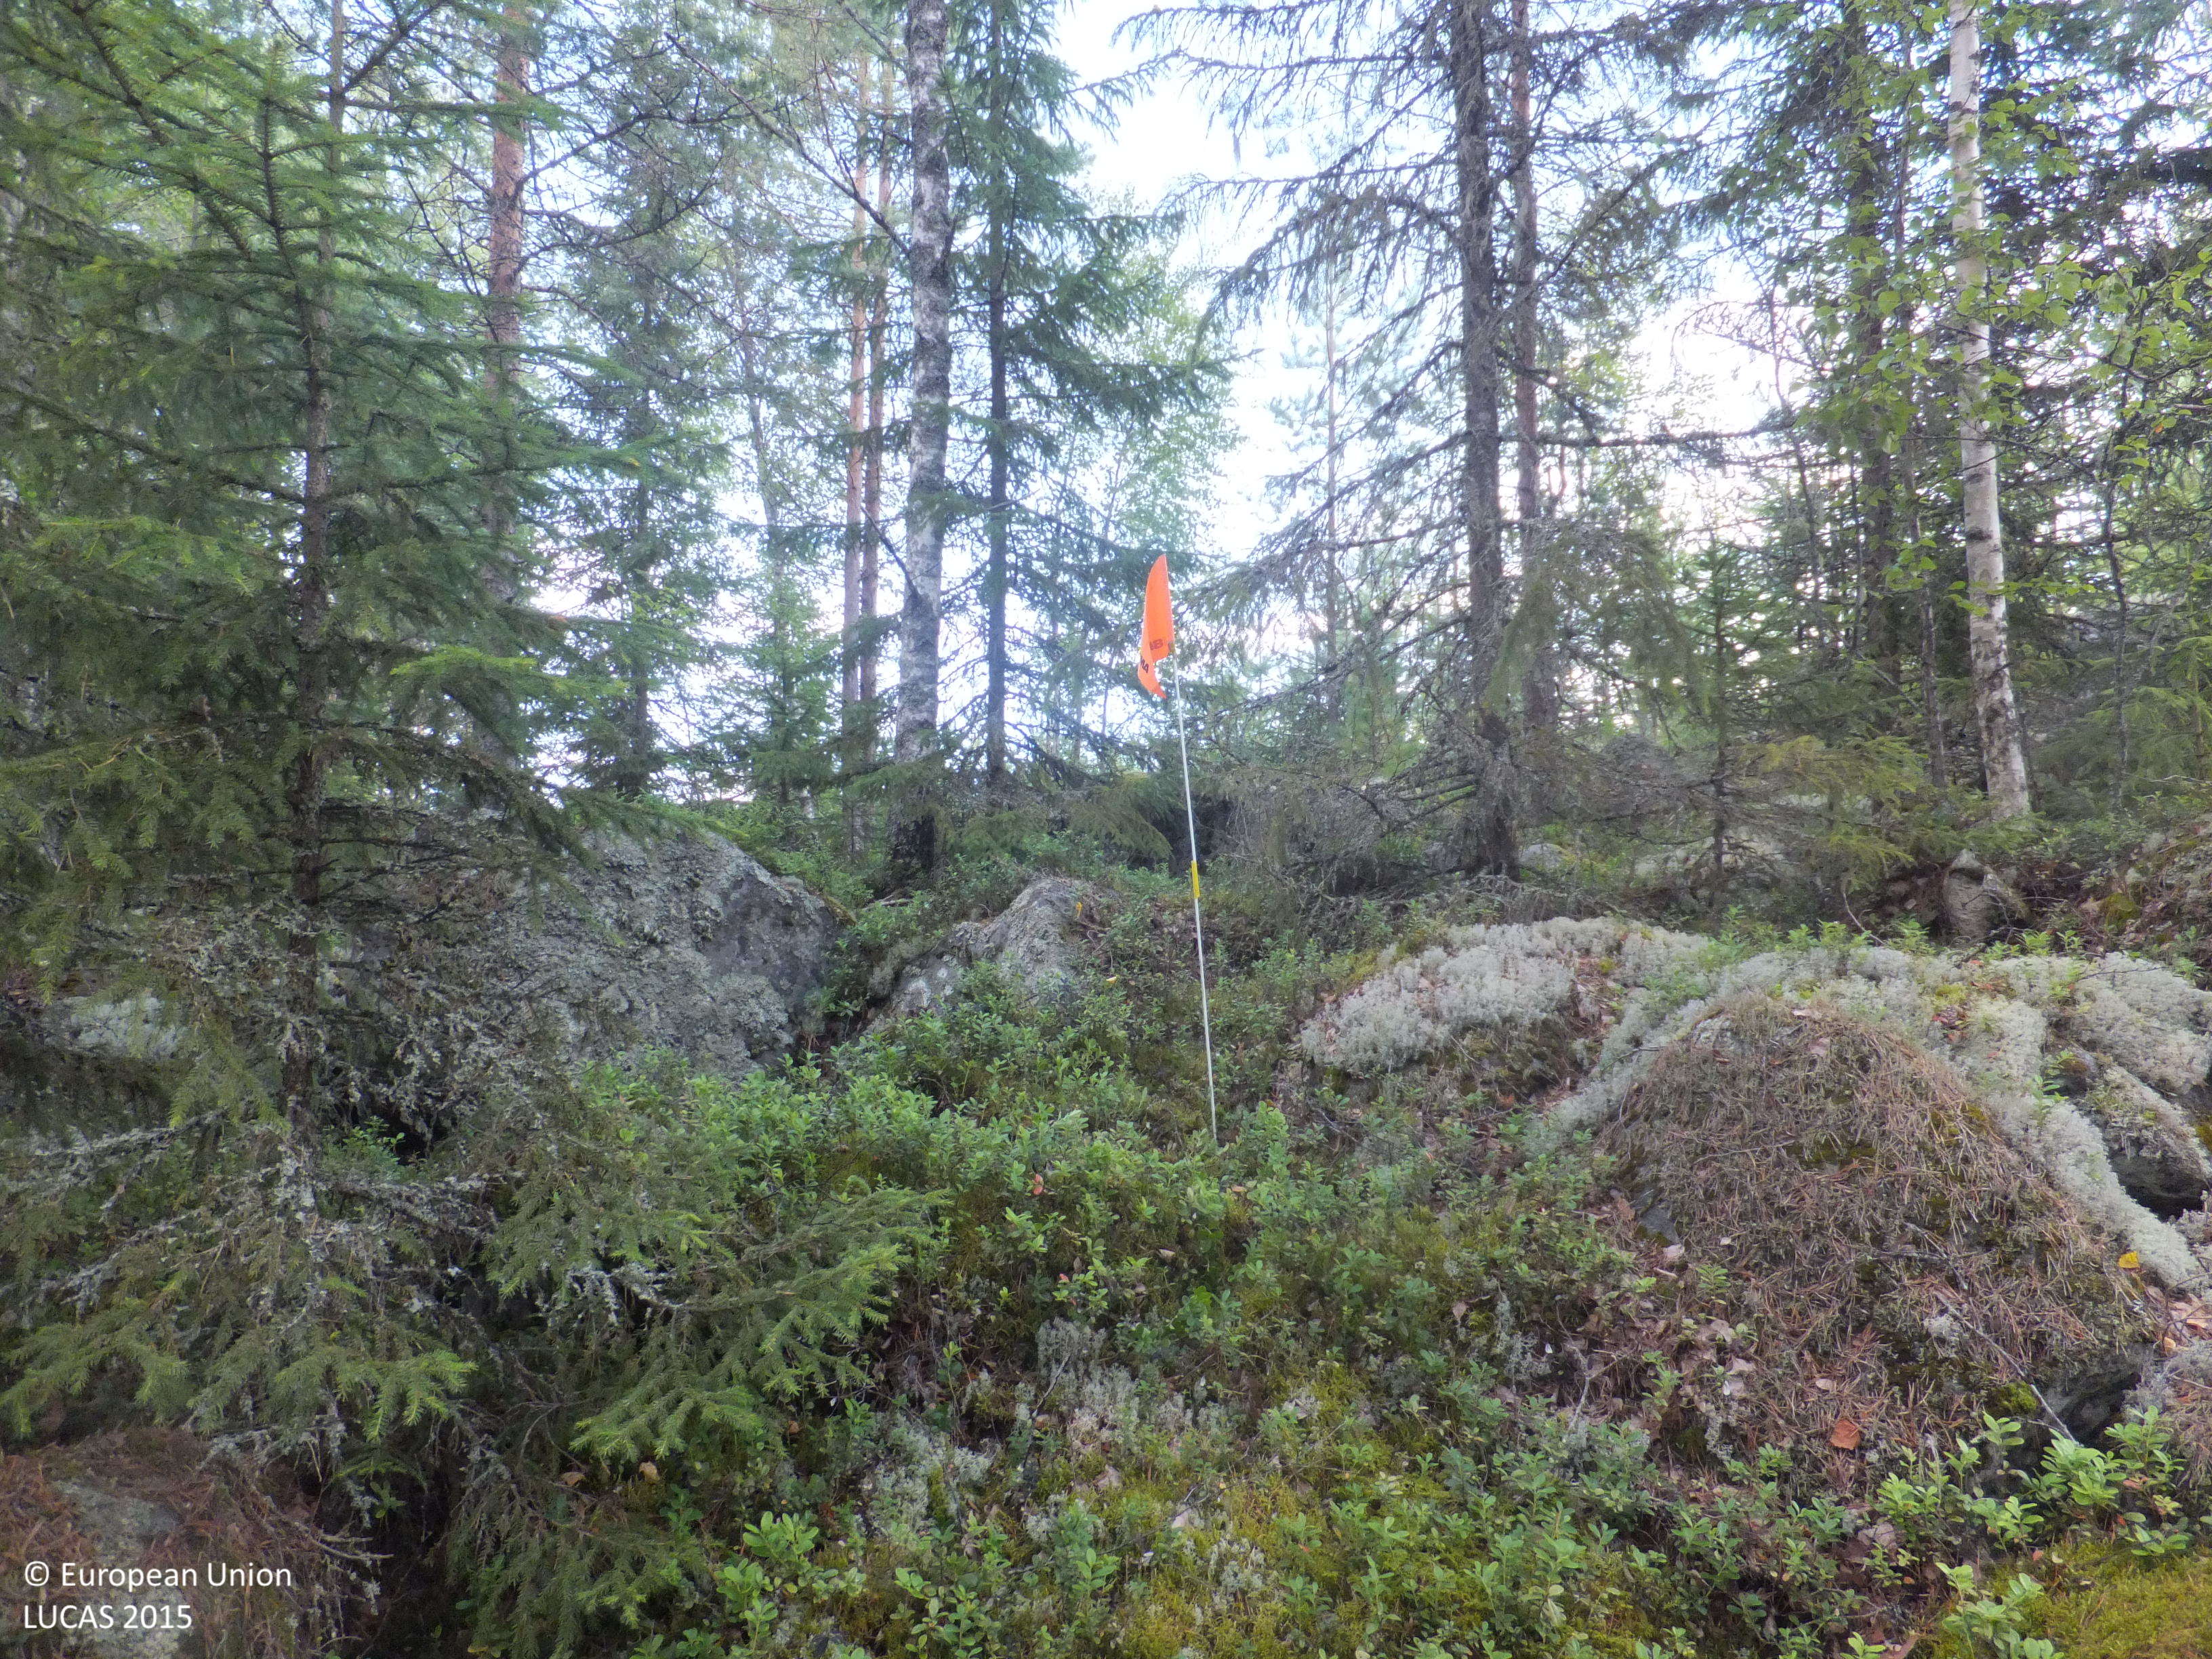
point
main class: Woodland
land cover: Other mixed woodland
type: boreal forest
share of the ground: 50 - 75 %
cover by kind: coniferous forest trees 30 %, broadleaved forest trees 30 %, shrubs 15 %, lichens and mosses 15 %, consolidated bare surface 10 %
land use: Forestry
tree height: > 5 m
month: July
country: FI
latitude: 63.2296
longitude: 22.2047
